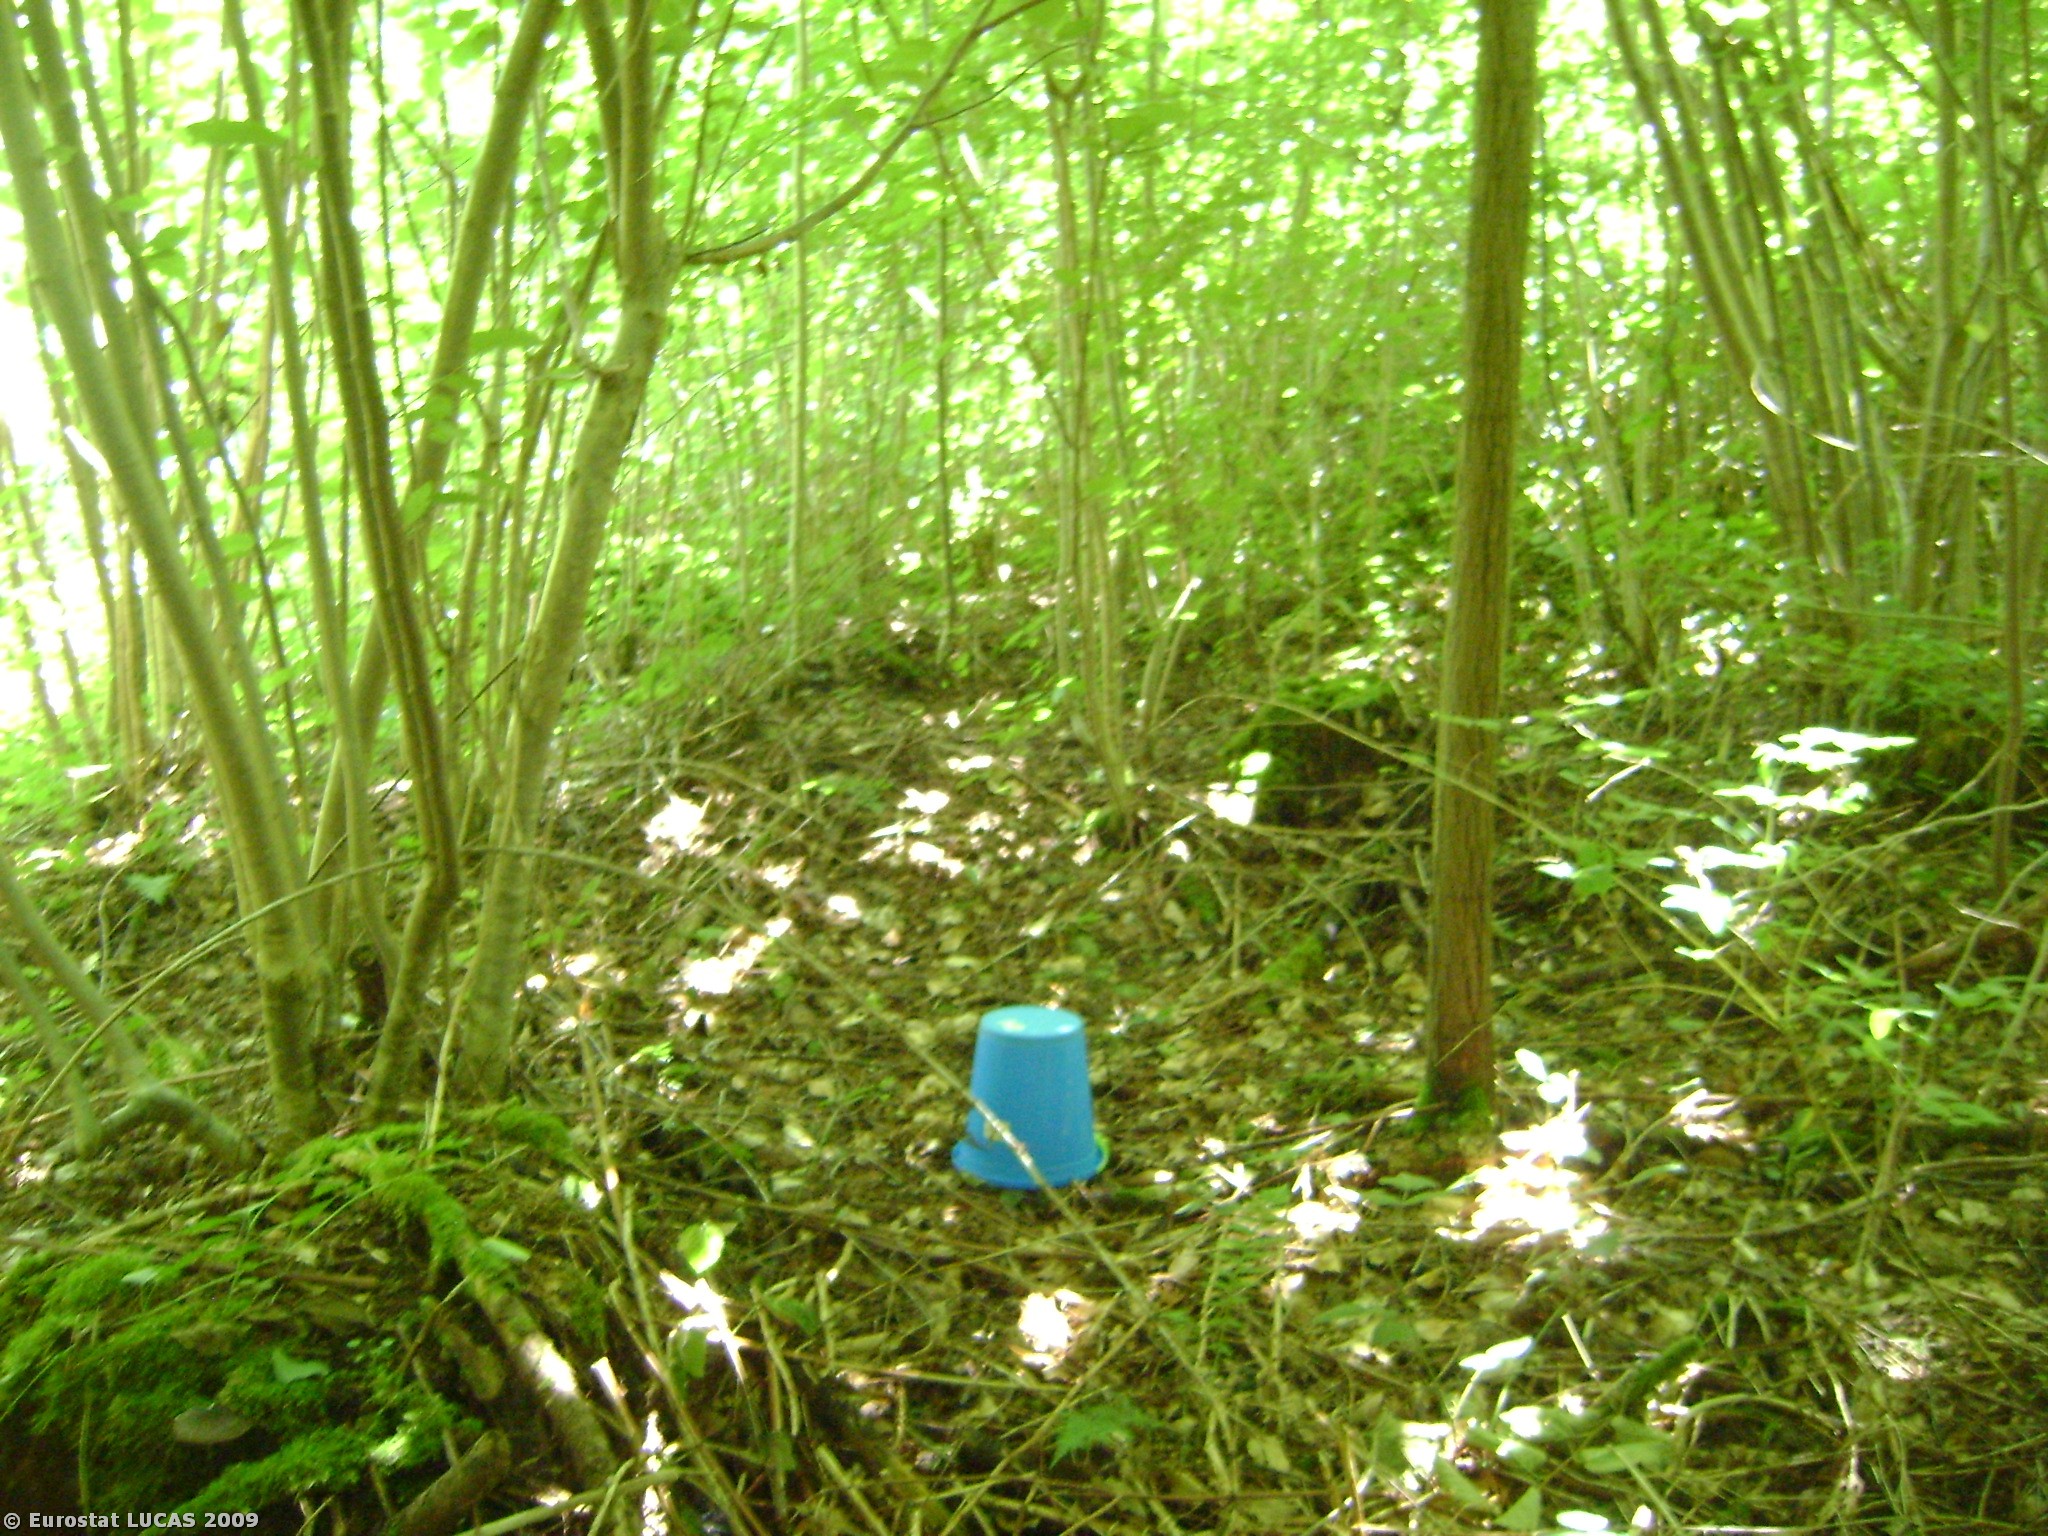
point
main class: Woodland
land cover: Broadleaved woodland
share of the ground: > 75 %
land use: Forestry
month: July
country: AT
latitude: 47.1971
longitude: 9.6703
